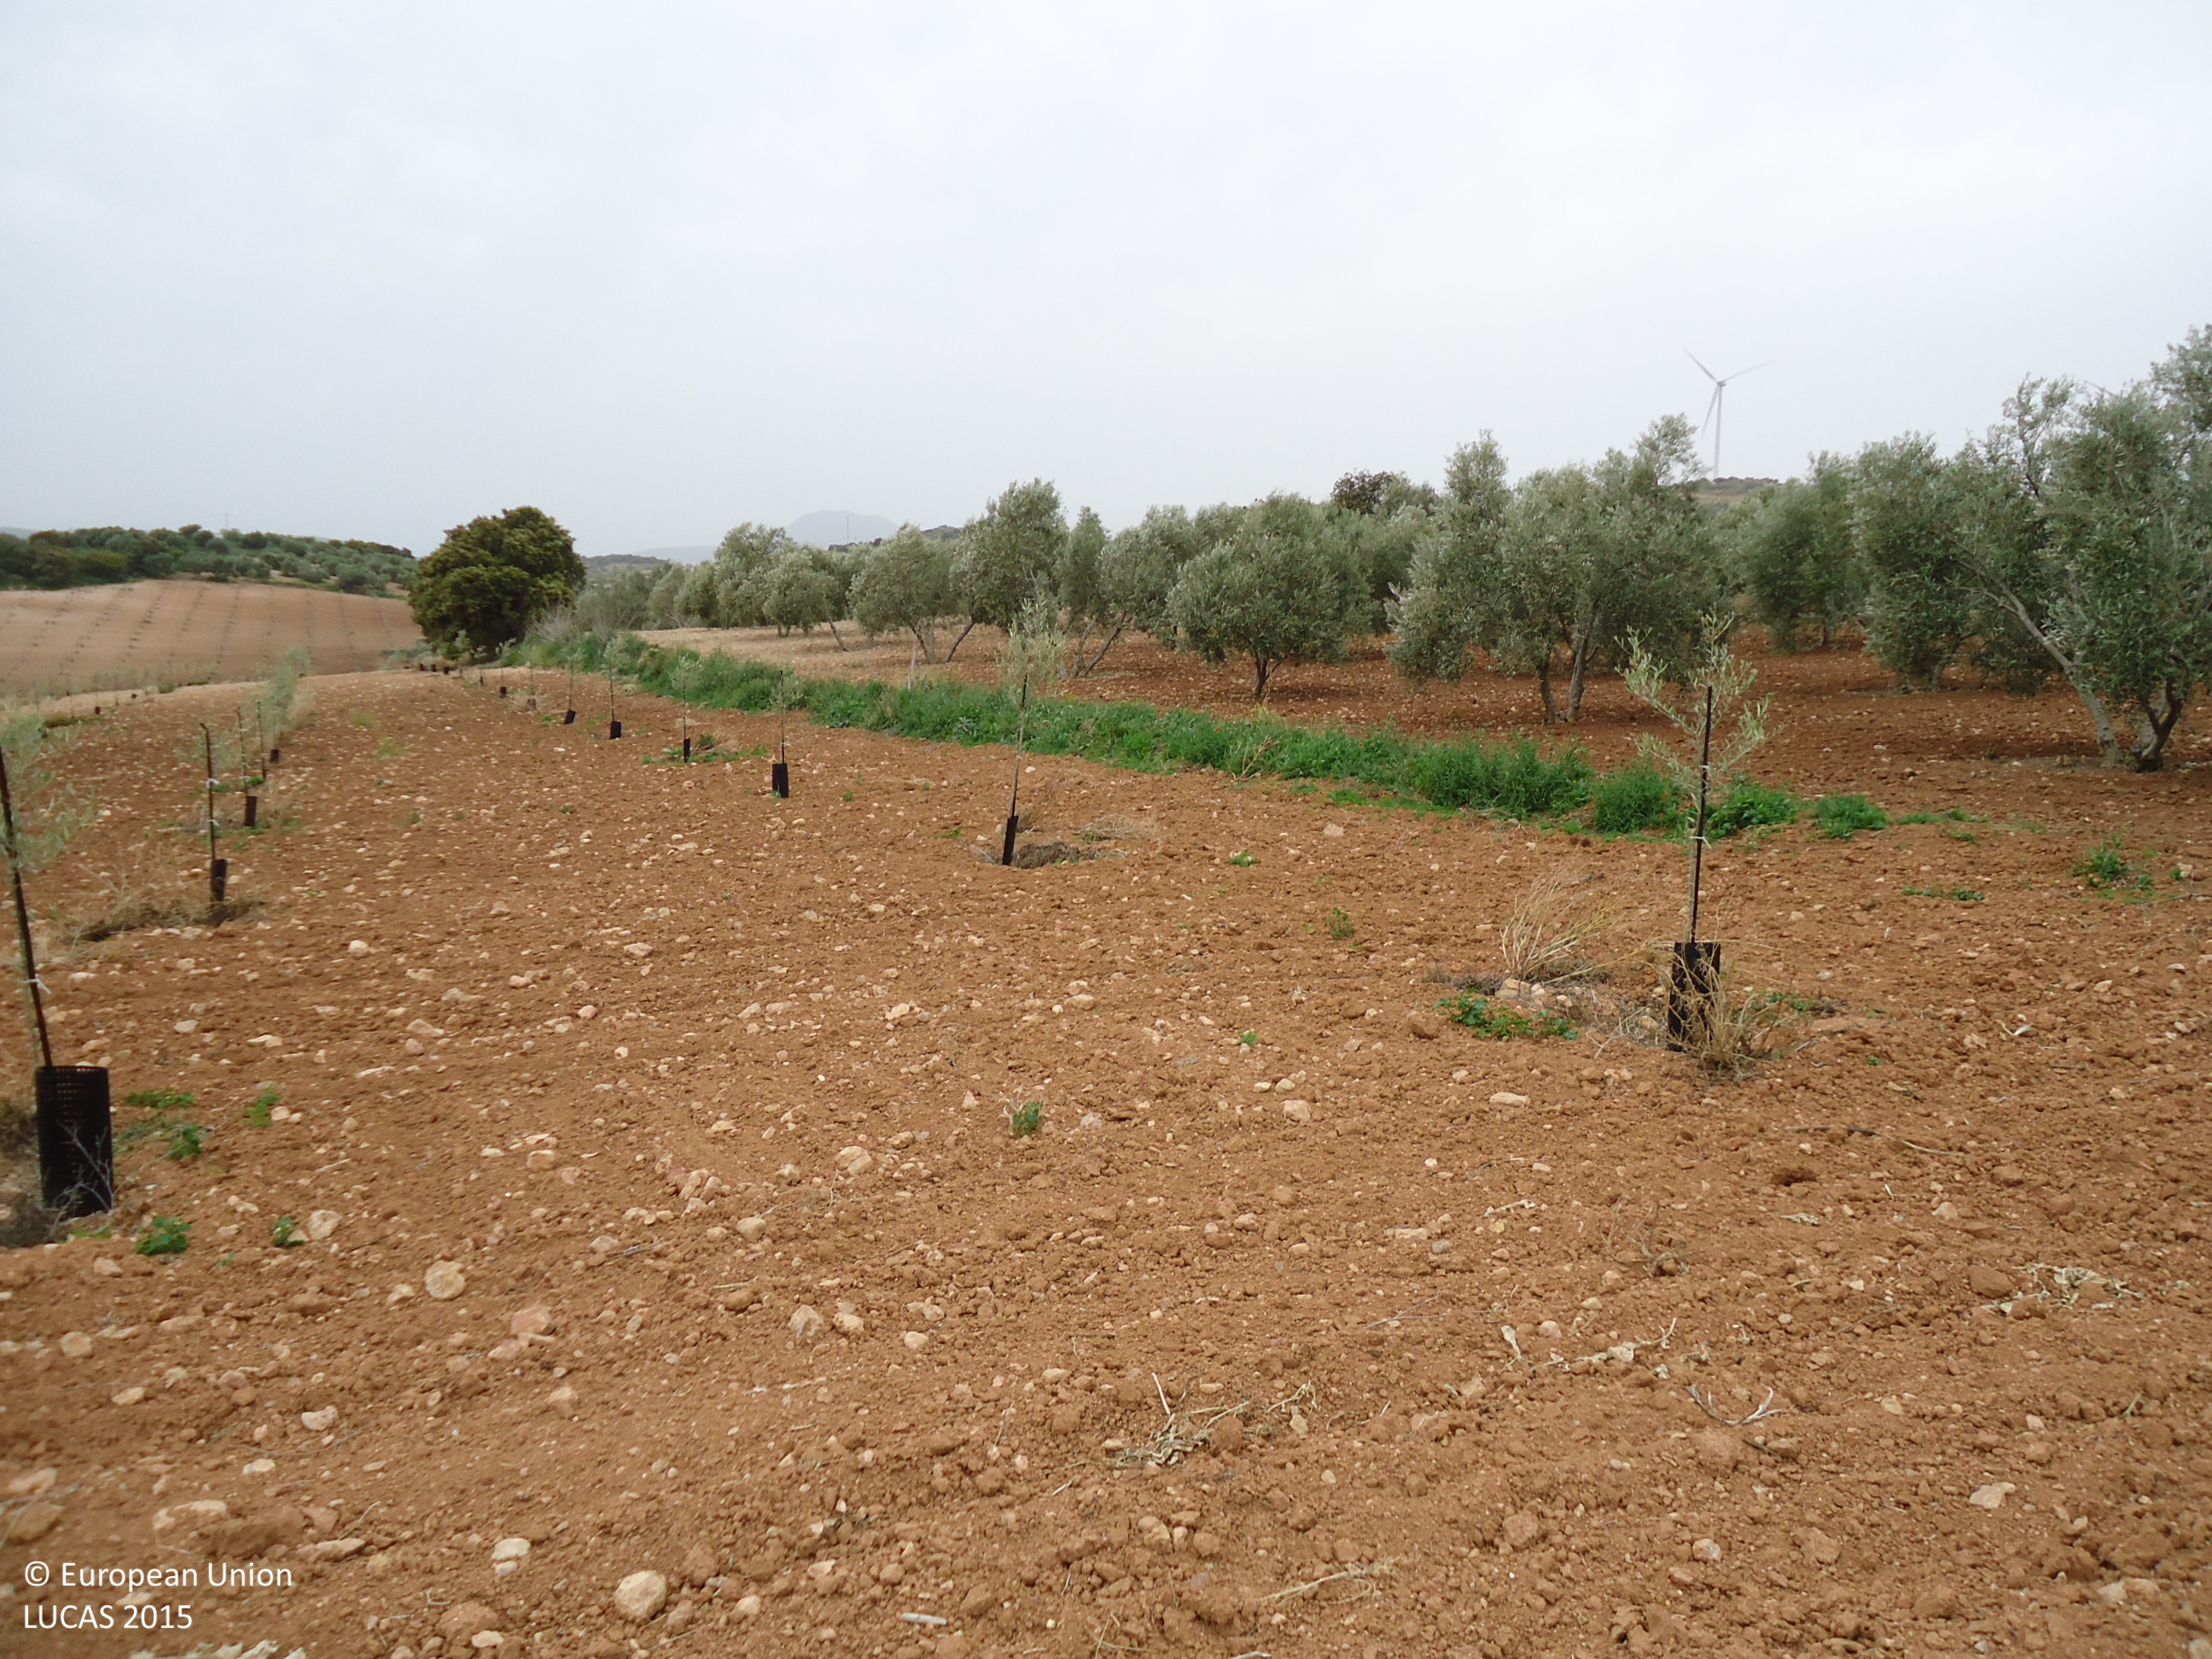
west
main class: Cropland
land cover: Olive groves
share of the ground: < 10 %
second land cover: Other bare soil
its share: > 75 %
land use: Agriculture (excluding fallow land and kitchen gardens)
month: April
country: ES
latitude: 37.0098
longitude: -5.0054
